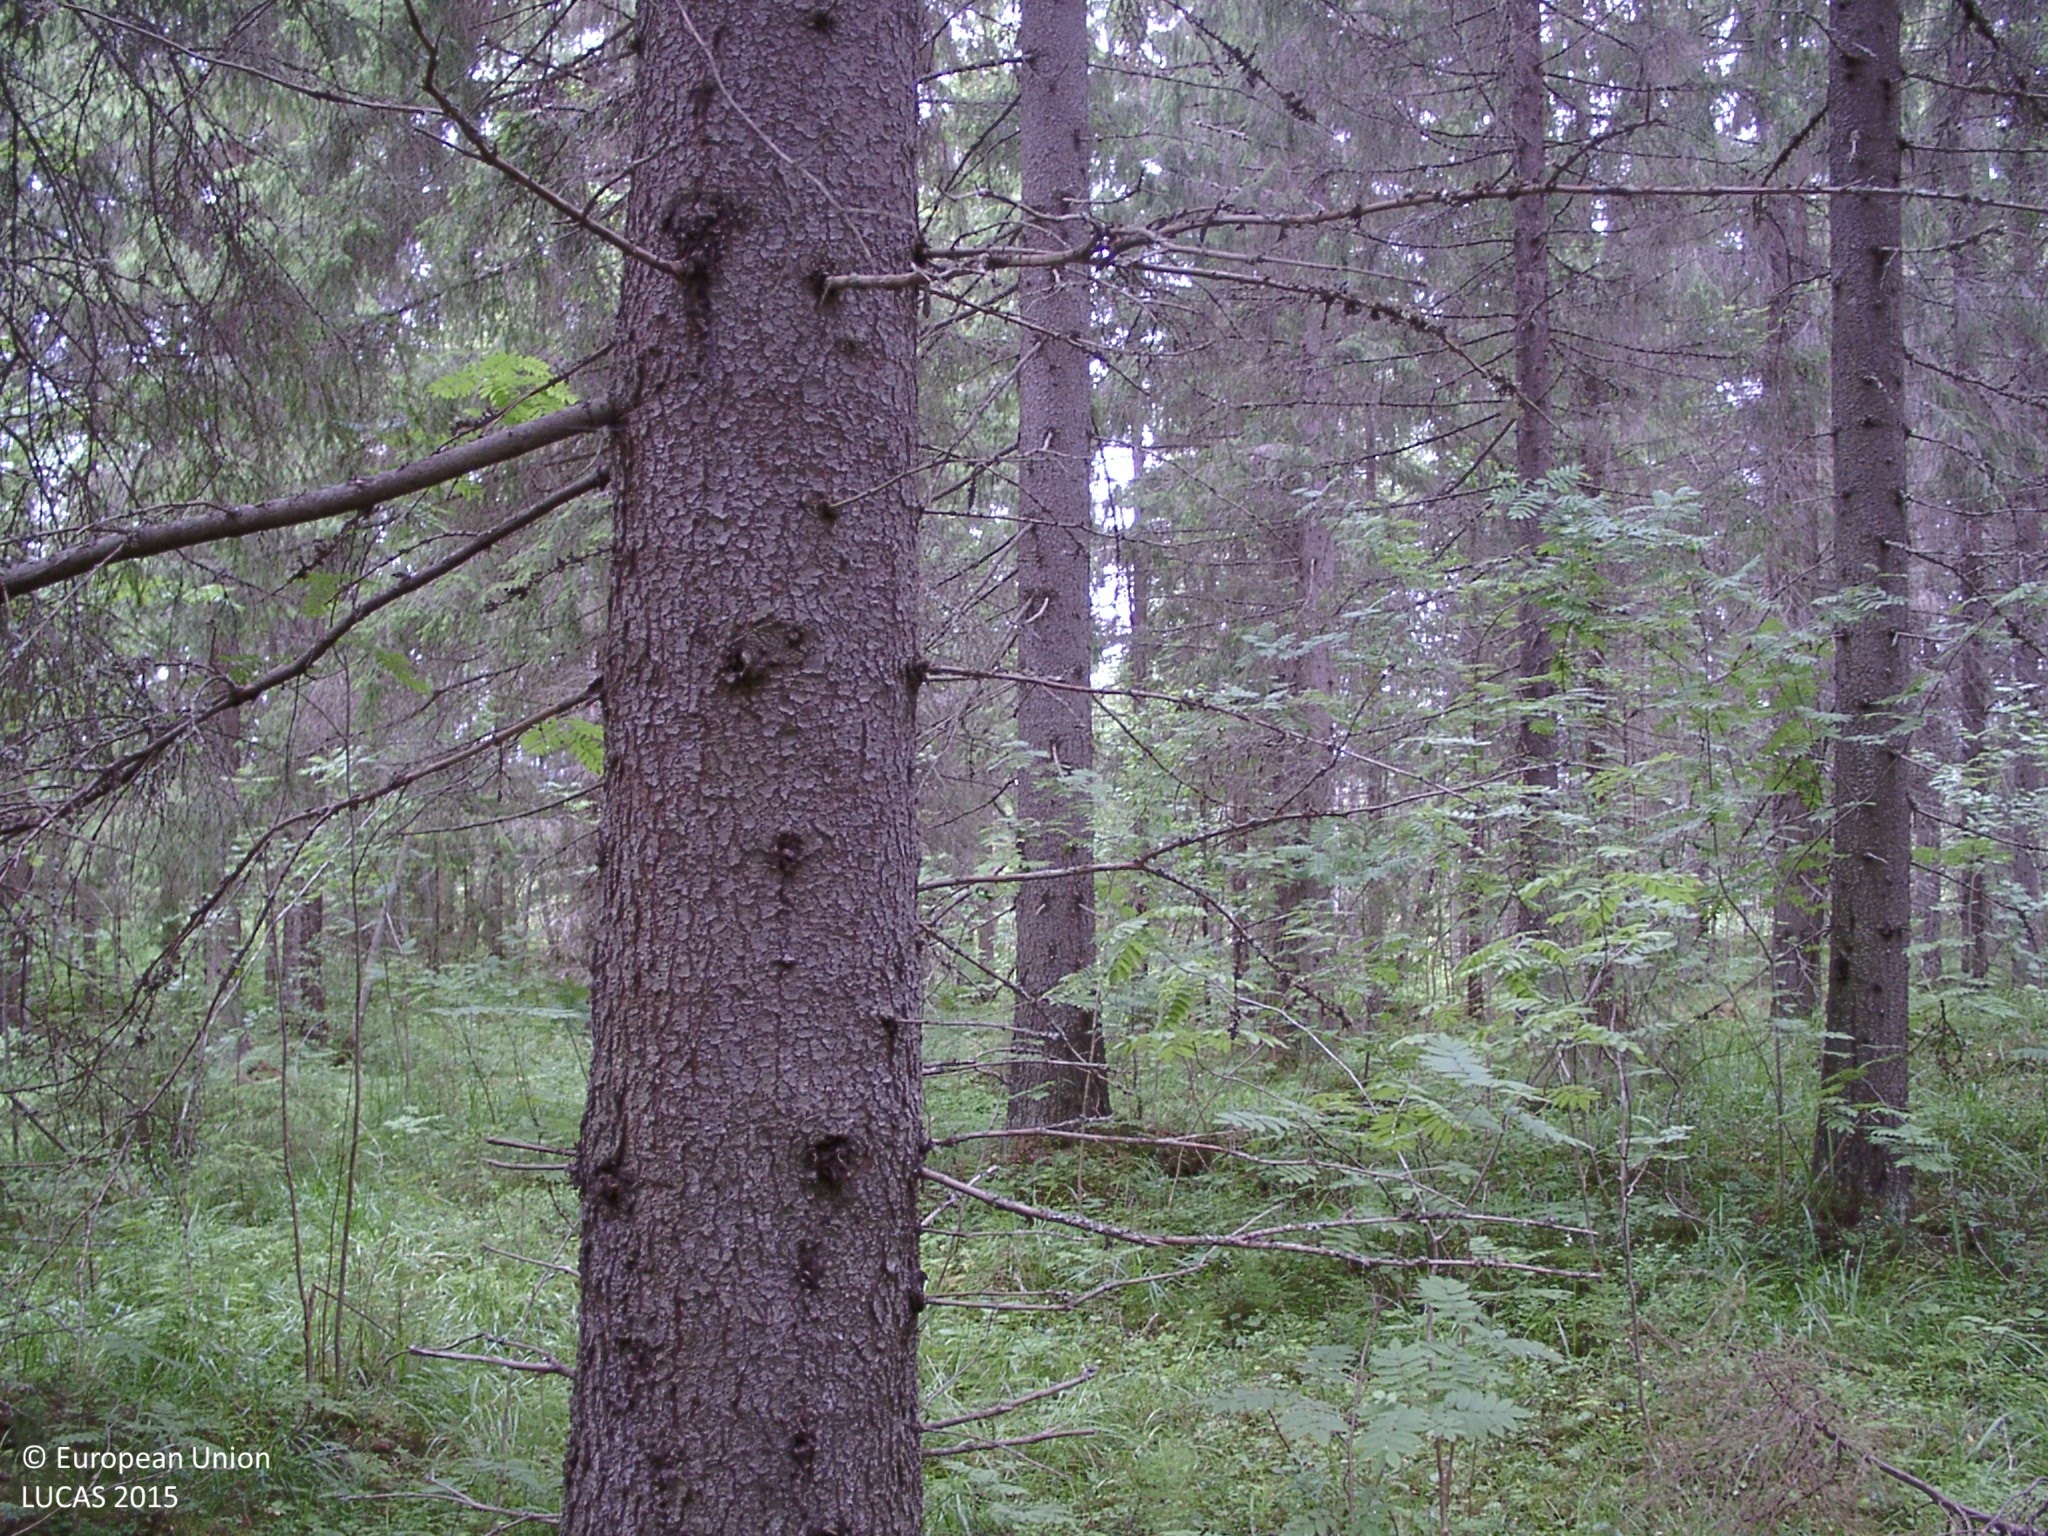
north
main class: Woodland
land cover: Spruce dominated coniferous woodland
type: boreal forest
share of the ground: 50 - 75 %
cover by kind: coniferous forest trees 55 %, broadleaved forest trees 15 %, herbaceous plants 15 %, shrubs 10 %, lichens and mosses 5 %
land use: Semi-natural and natural areas not in use
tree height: > 5 m
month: July
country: FI
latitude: 61.6813
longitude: 25.2498
